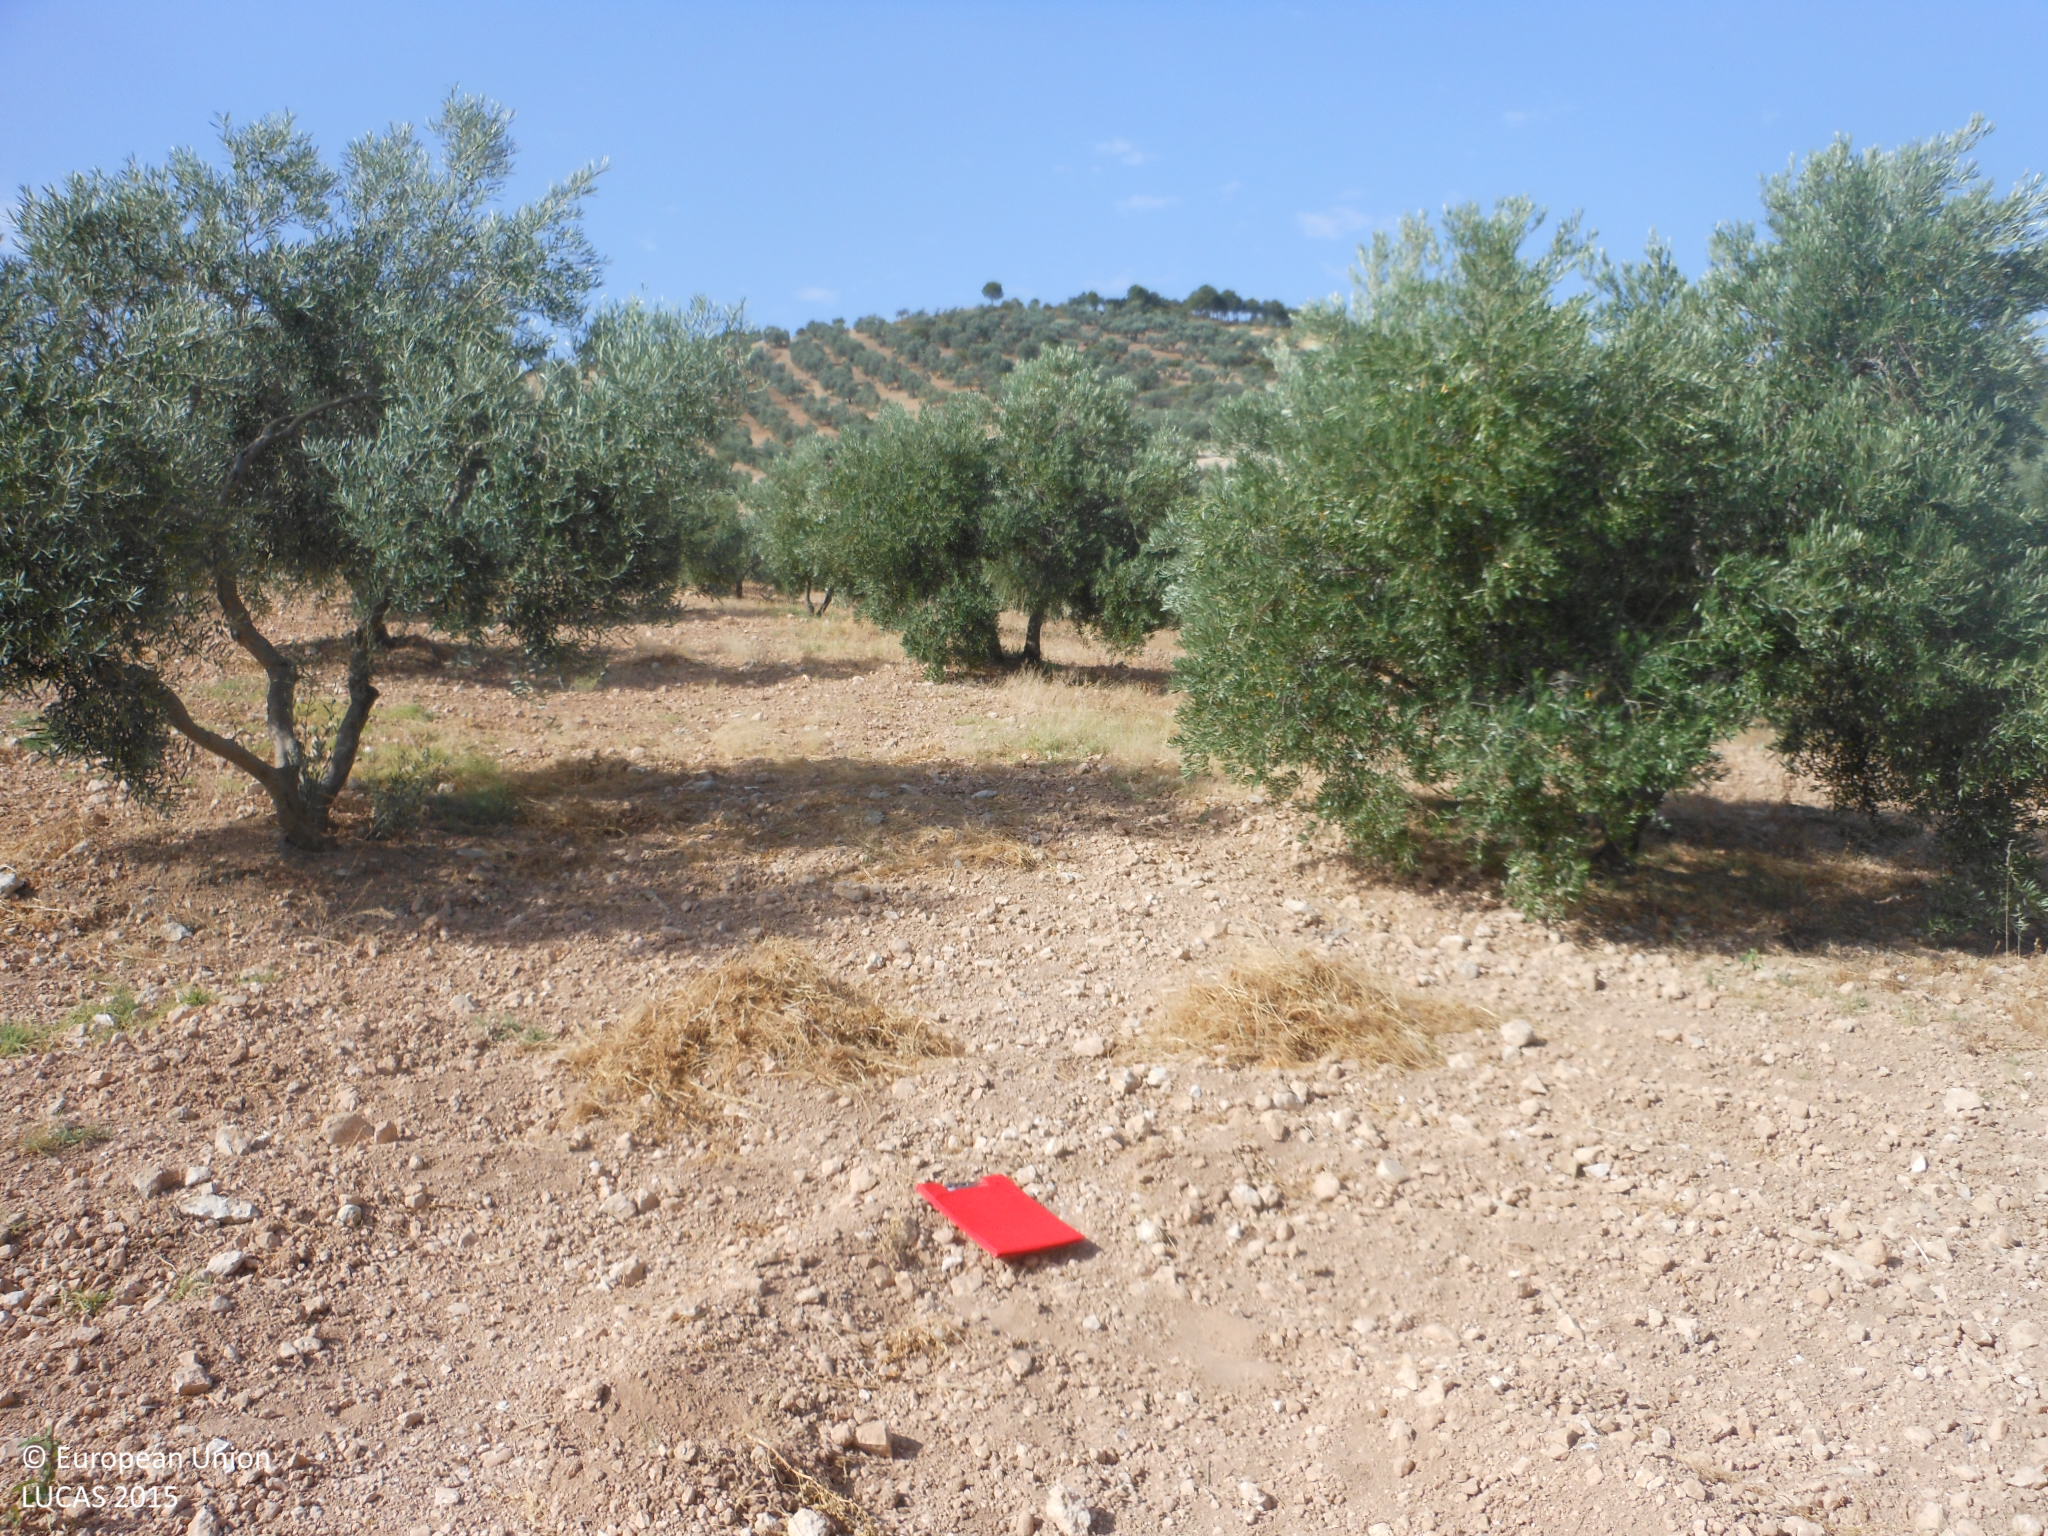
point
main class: Cropland
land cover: Olive groves
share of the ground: 25 - 50 %
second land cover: Other bare soil
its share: > 75 %
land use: Agriculture (excluding fallow land and kitchen gardens)
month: July
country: ES
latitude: 37.0987
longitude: -5.0248
